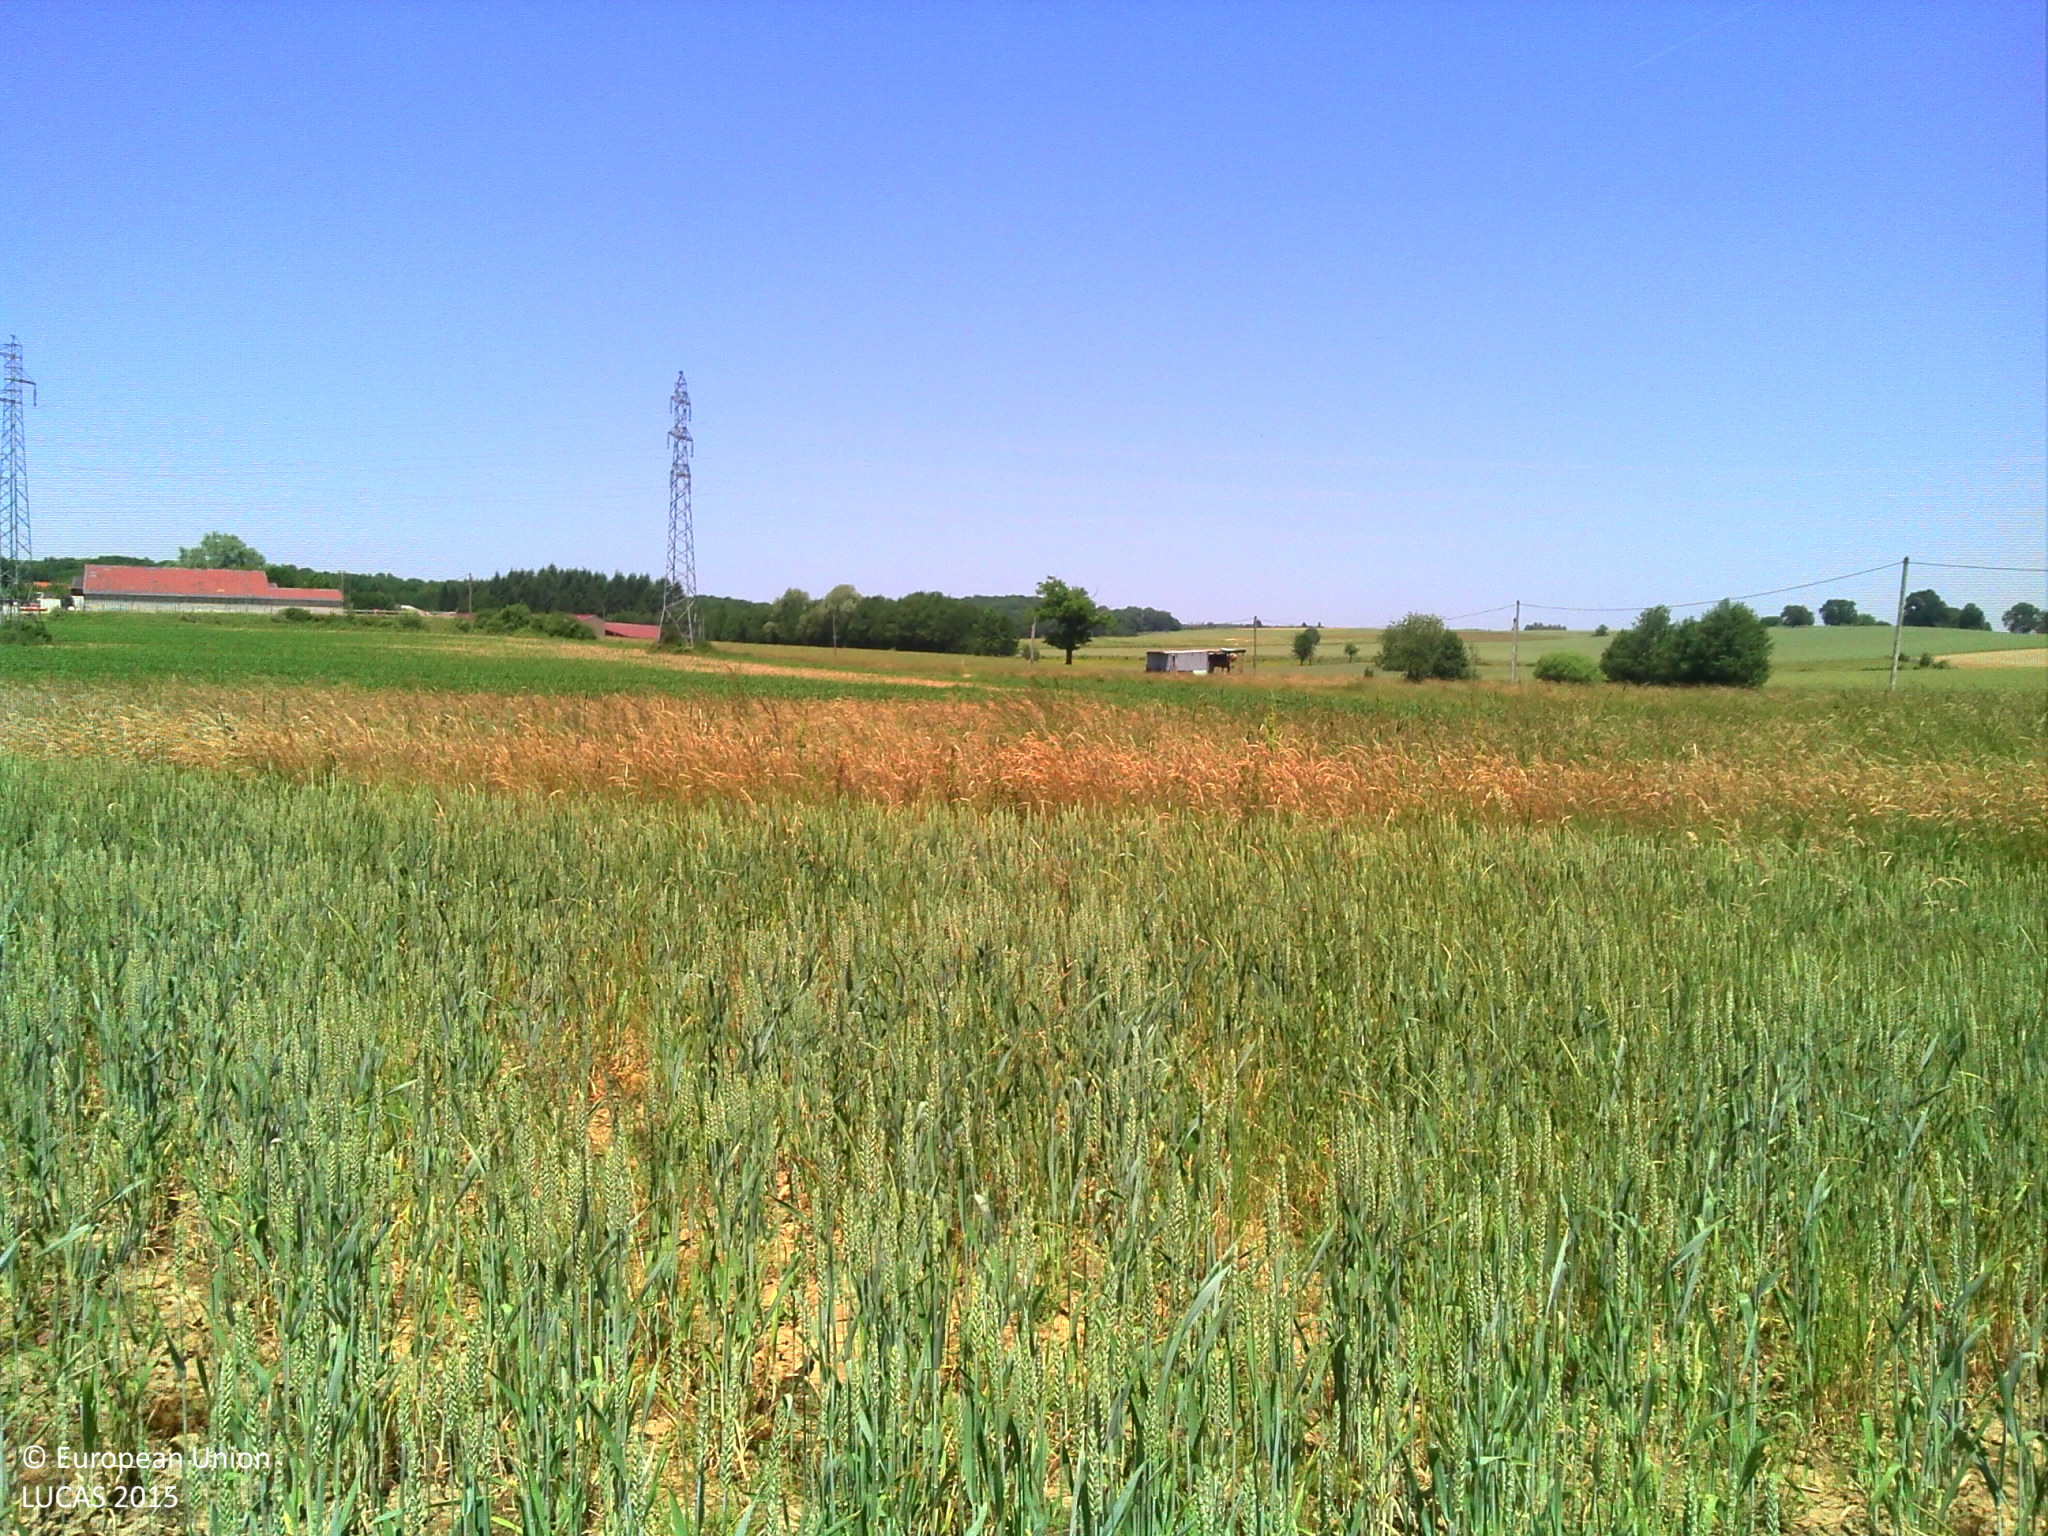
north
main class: Cropland
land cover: Common wheat
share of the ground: > 75 %
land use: Agriculture (excluding fallow land and kitchen gardens)
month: June
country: FR
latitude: 47.6690
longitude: 6.1257
